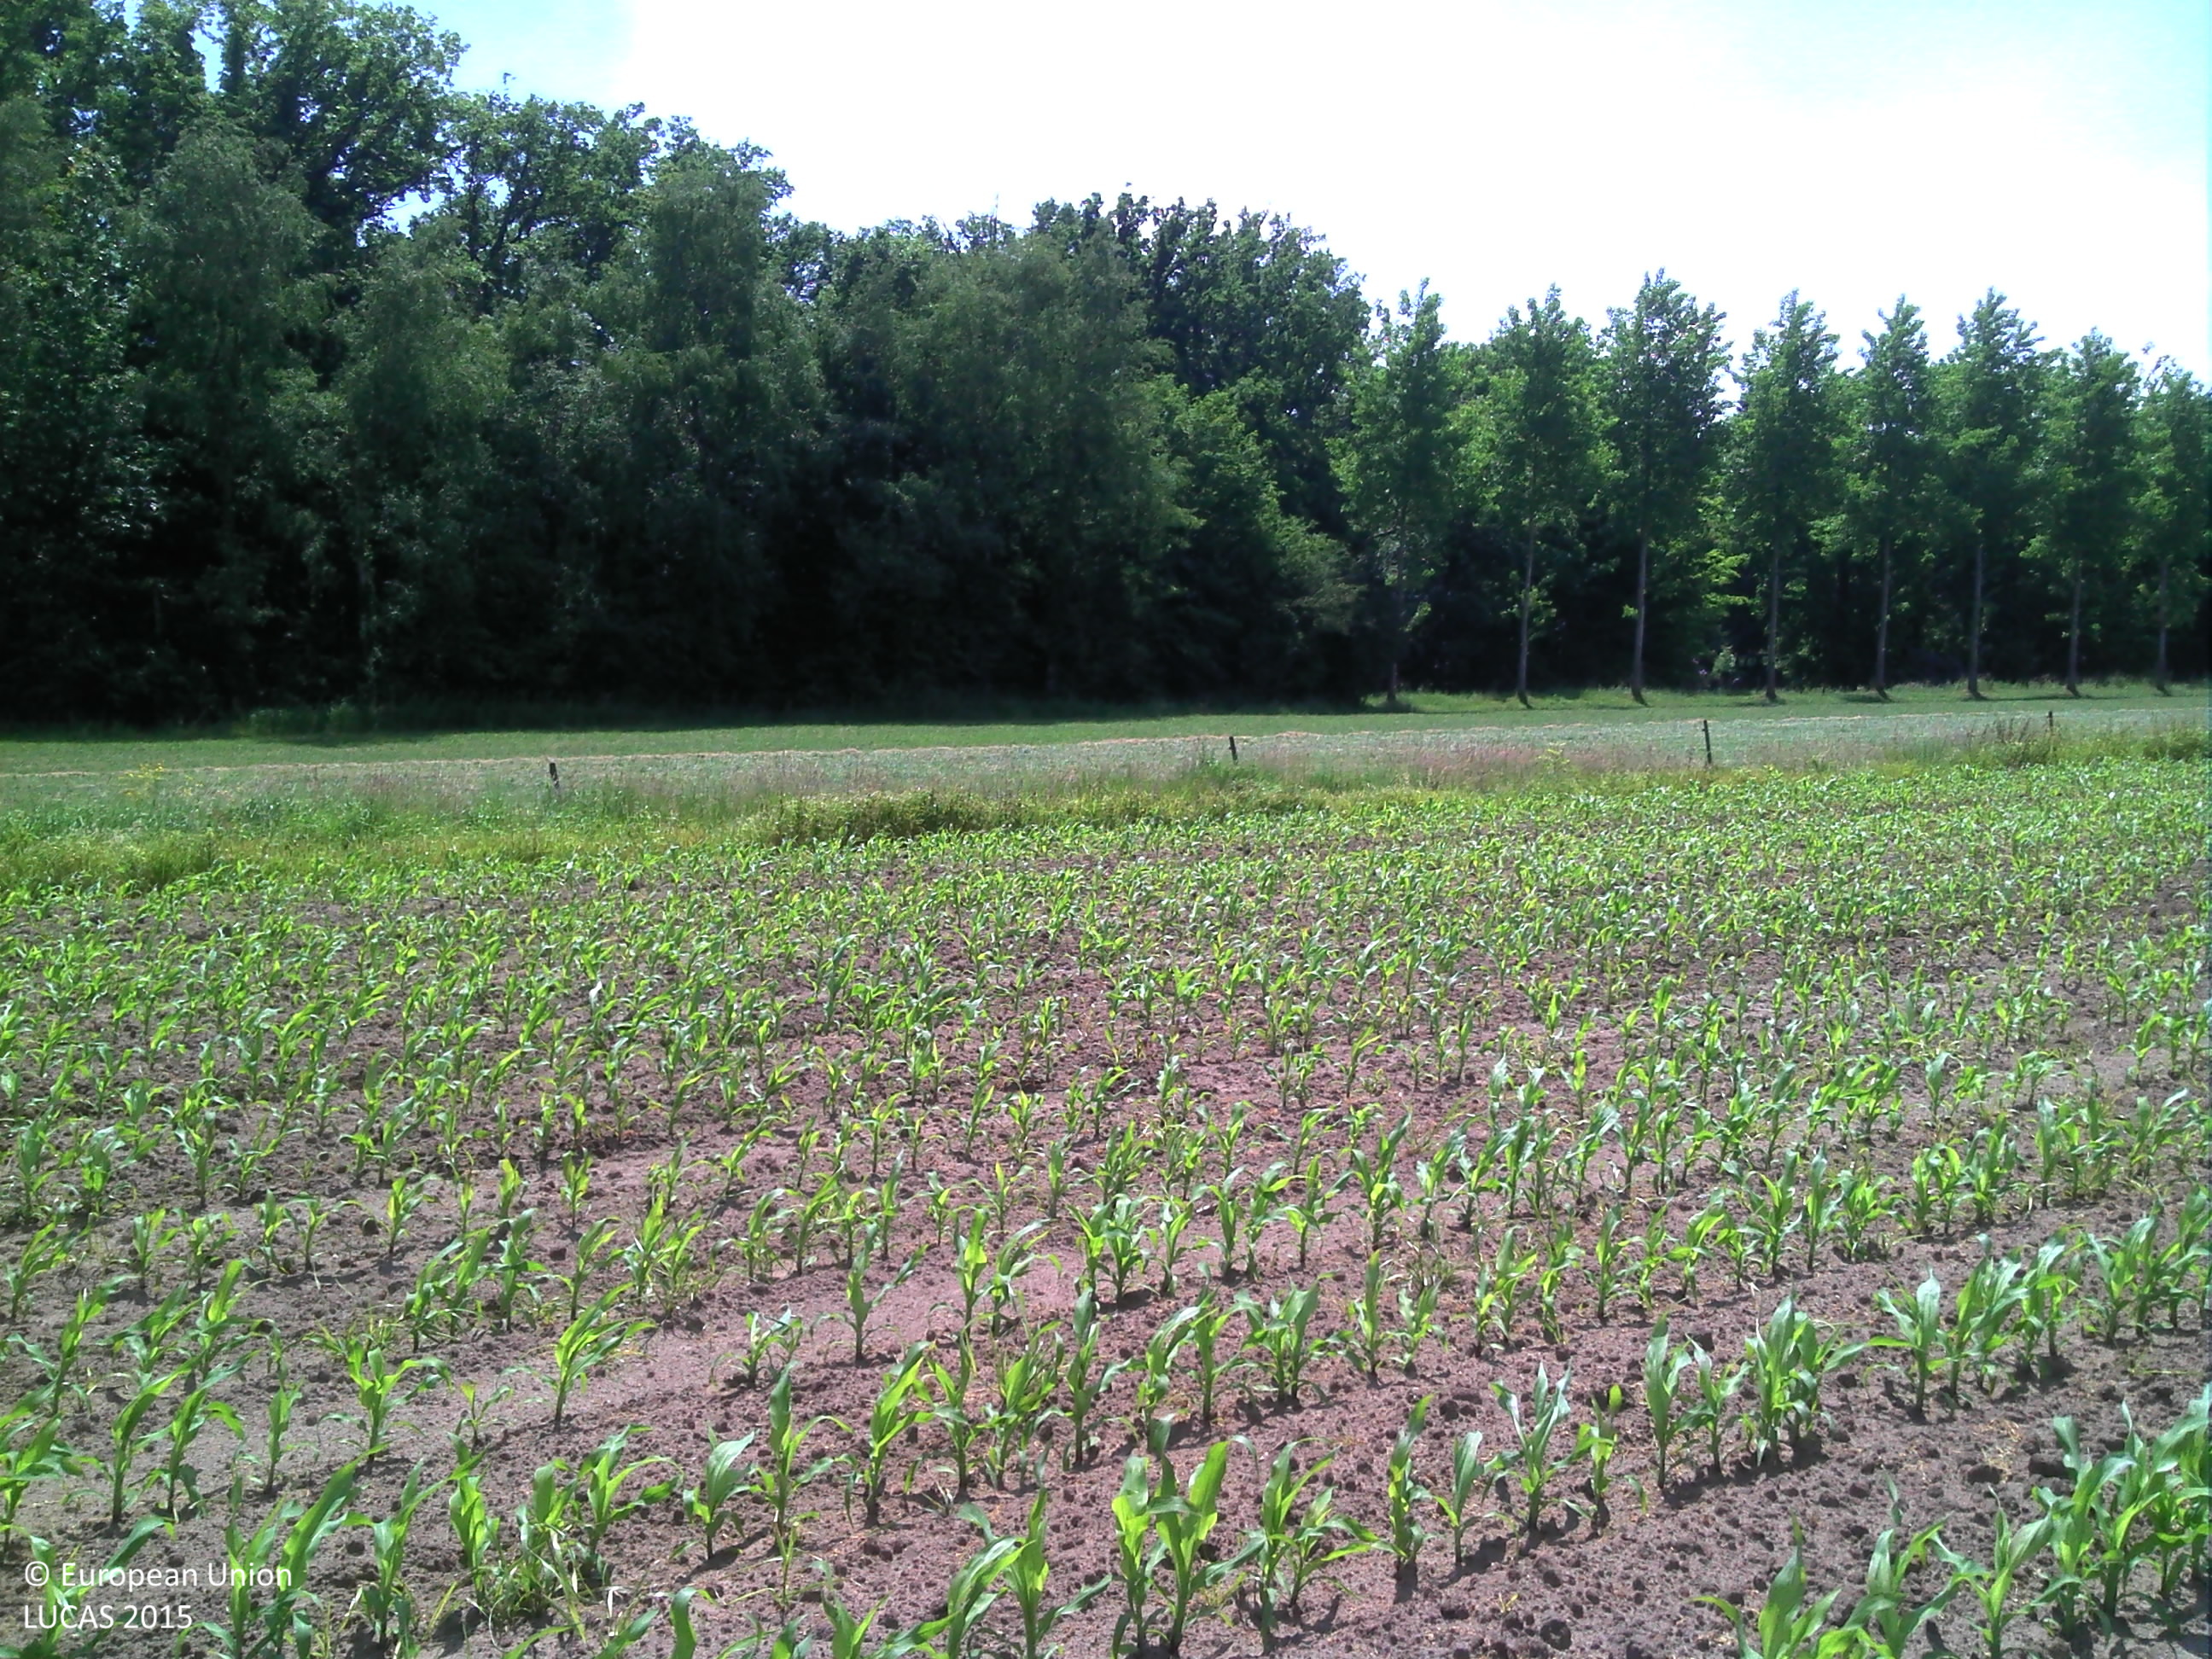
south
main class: Cropland
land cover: Maize
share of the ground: 25 - 50 %
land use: Agriculture (excluding fallow land and kitchen gardens)
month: June
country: BE
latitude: 50.9837
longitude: 5.1971
